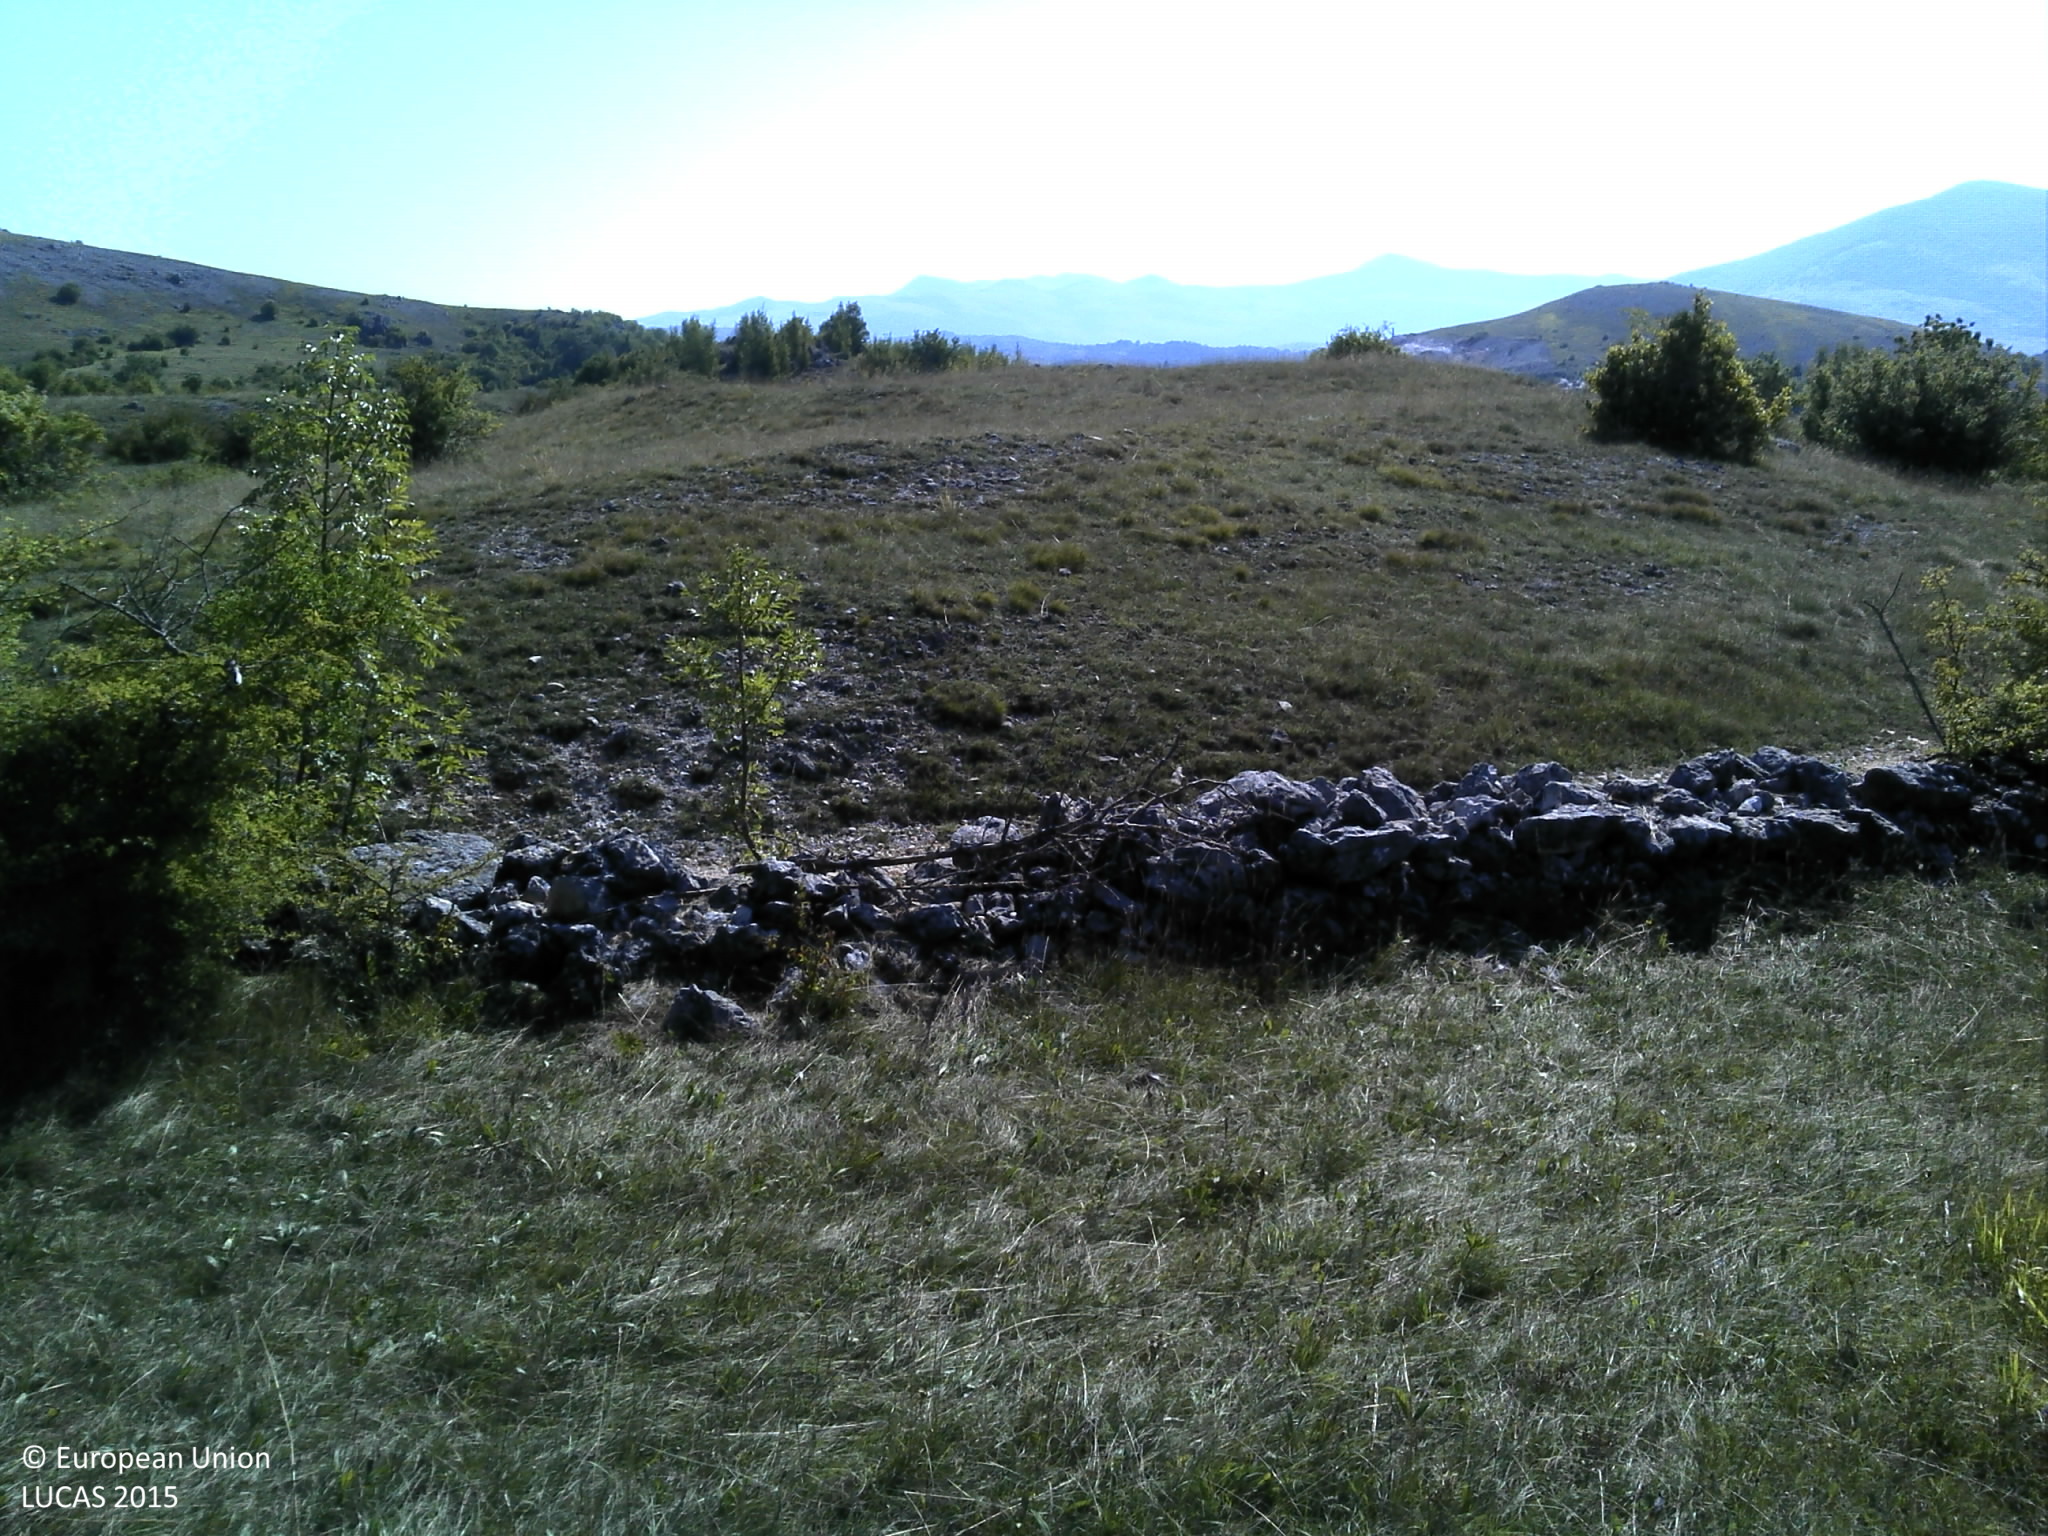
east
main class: Grassland
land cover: Grassland with sparse tree/shrub cover
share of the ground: > 75 %
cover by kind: herbaceous plants 90 %, broadleaved forest trees 5 %, shrubs 5 %
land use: Abandoned areas
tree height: < 5 m
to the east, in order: Grassland with sparse tree/shrub cover; Dry stone walls; Tracks; Grassland without tree/shrub cover; Shrubland with sparse tree cover; Grassland with sparse tree/shrub cover
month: September
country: HR
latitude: 44.3661
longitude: 15.8533
